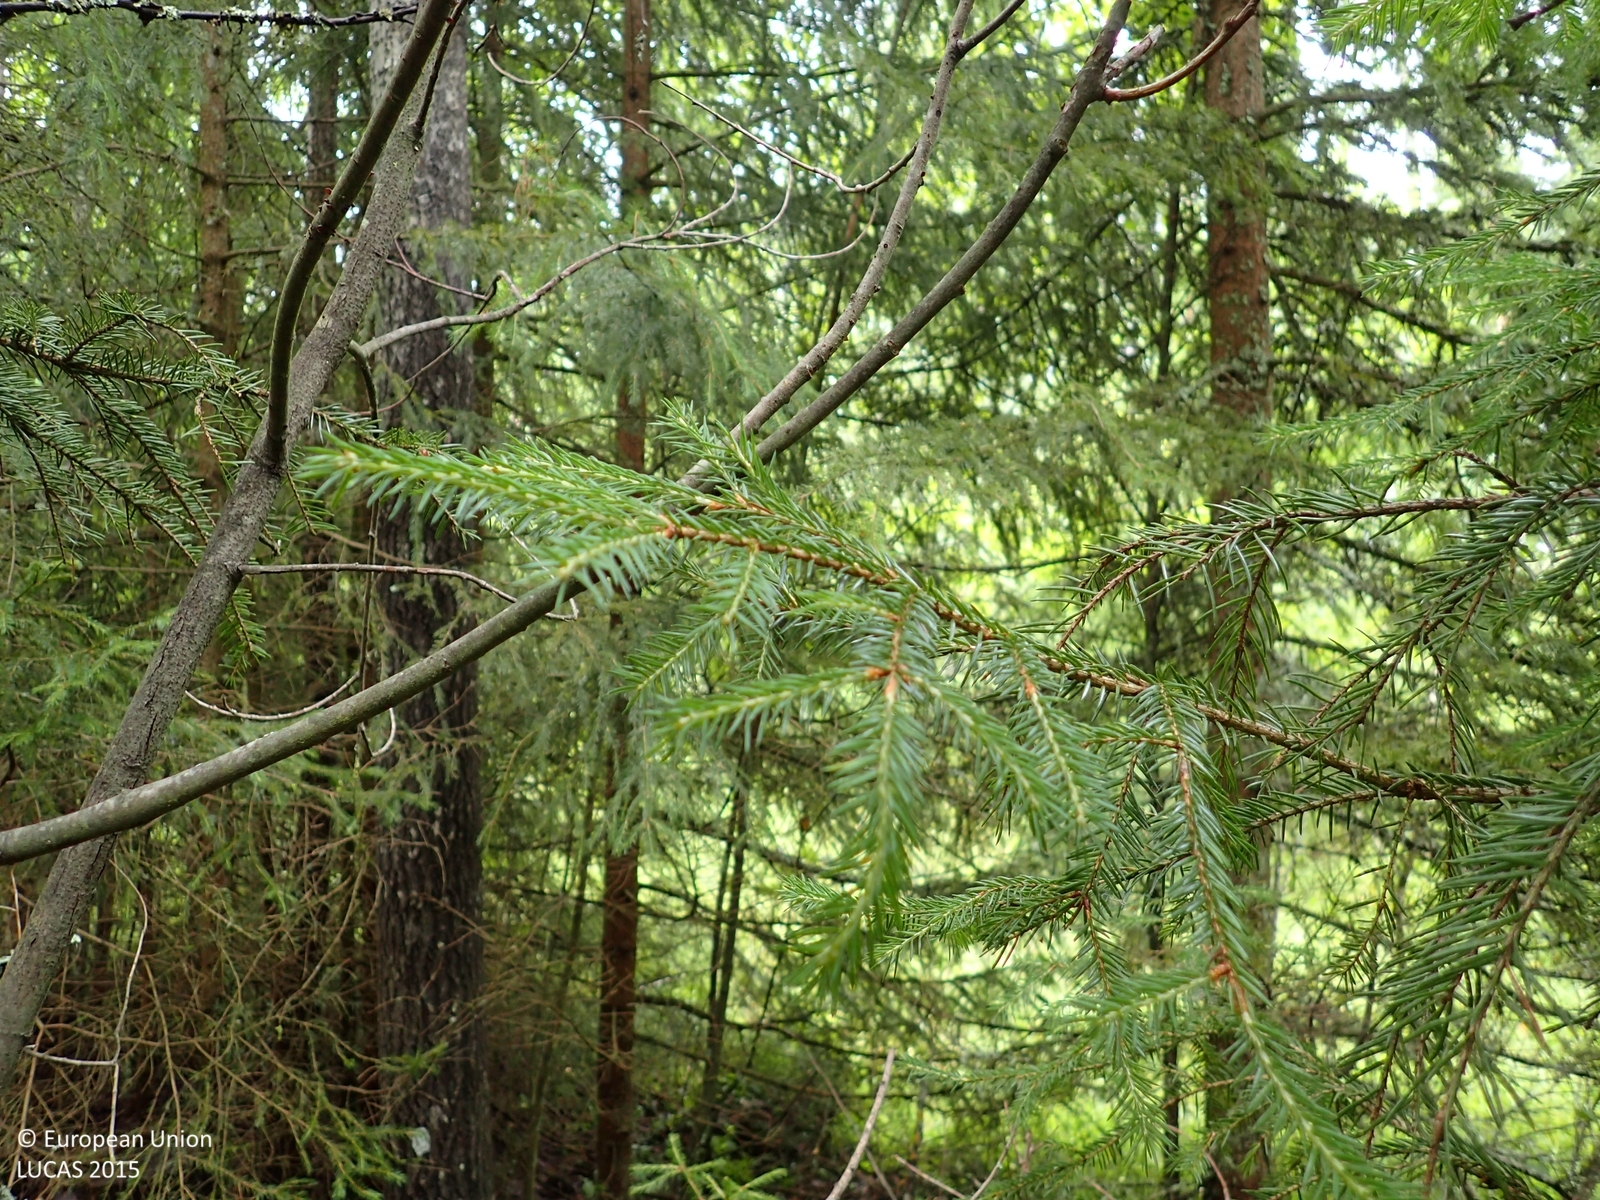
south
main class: Woodland
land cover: Spruce dominated mixed woodland
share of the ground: > 75 %
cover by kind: broadleaved forest trees 60 %, coniferous forest trees 20 %, shrubs 10 %, herbaceous plants 5 %, lichens and mosses 5 %
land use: Forestry
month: July
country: FI
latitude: 62.9387
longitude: 22.8438
